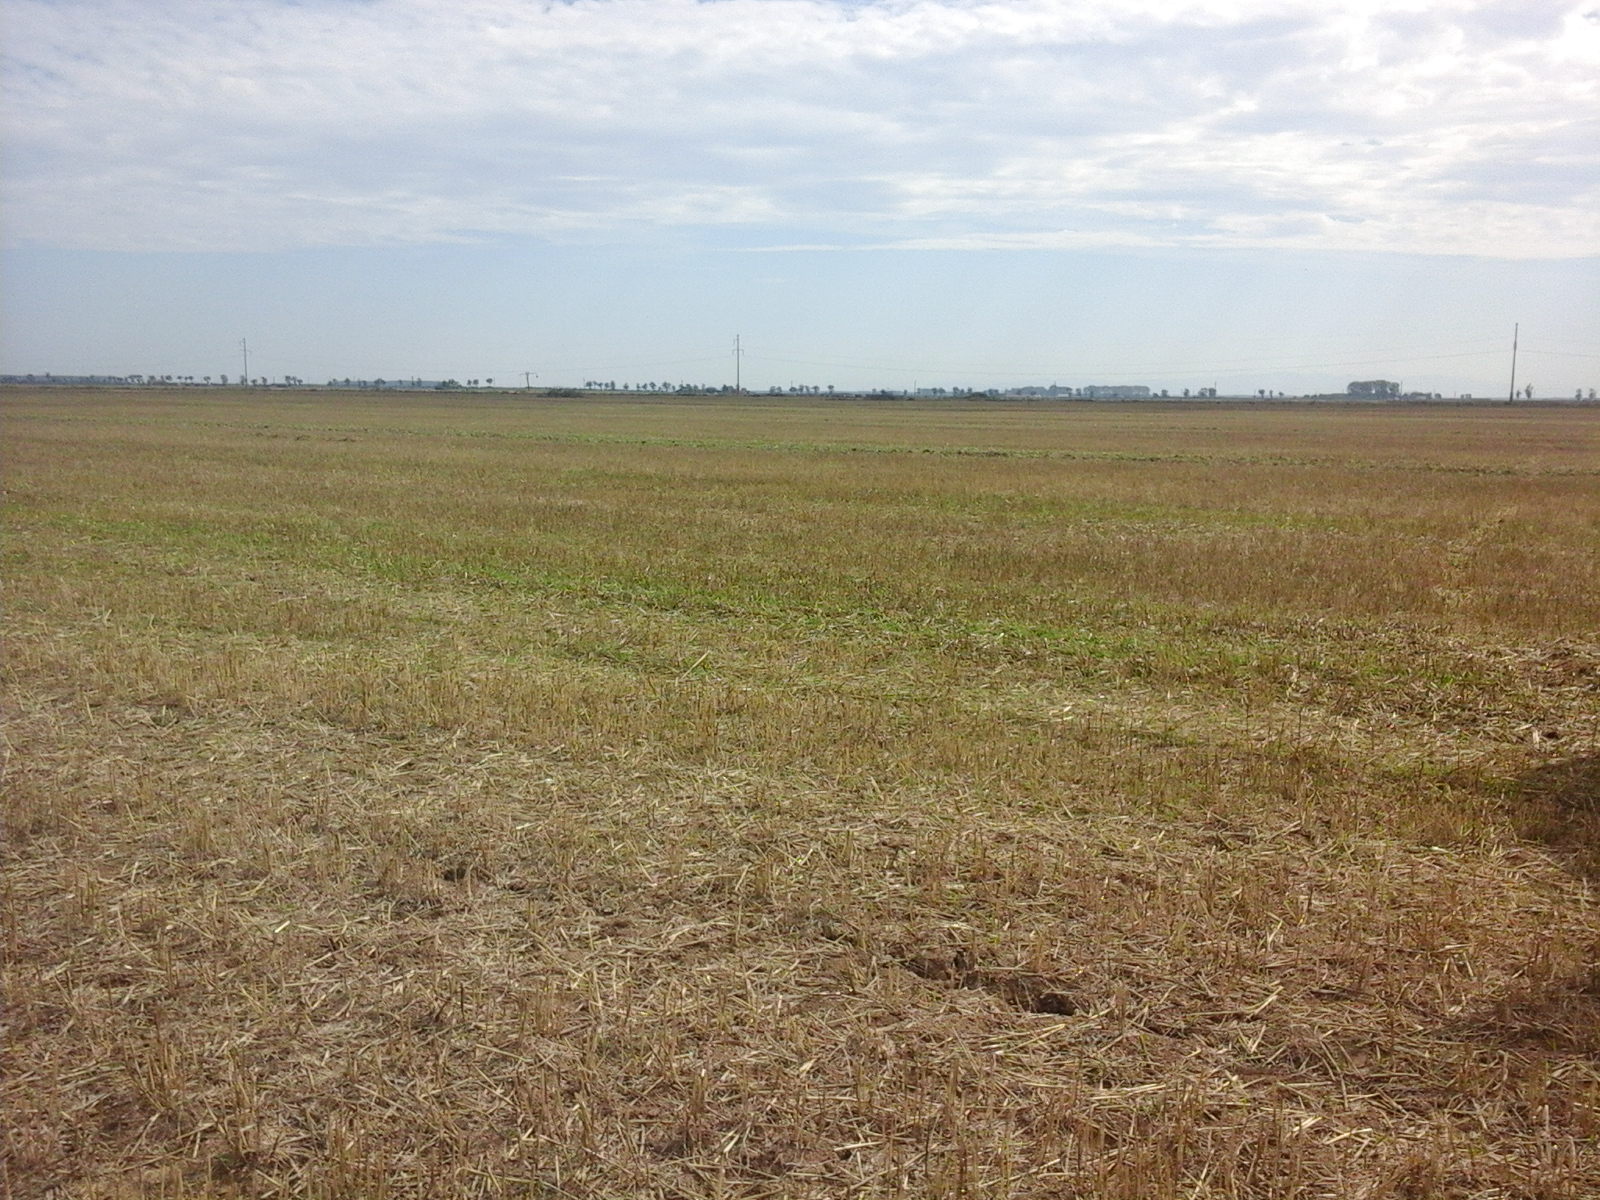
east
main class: Cropland
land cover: Common wheat
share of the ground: > 75 %
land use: Agriculture (excluding fallow land and kitchen gardens)
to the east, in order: Common wheat
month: August
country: RO
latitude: 46.5468
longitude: 21.5015
